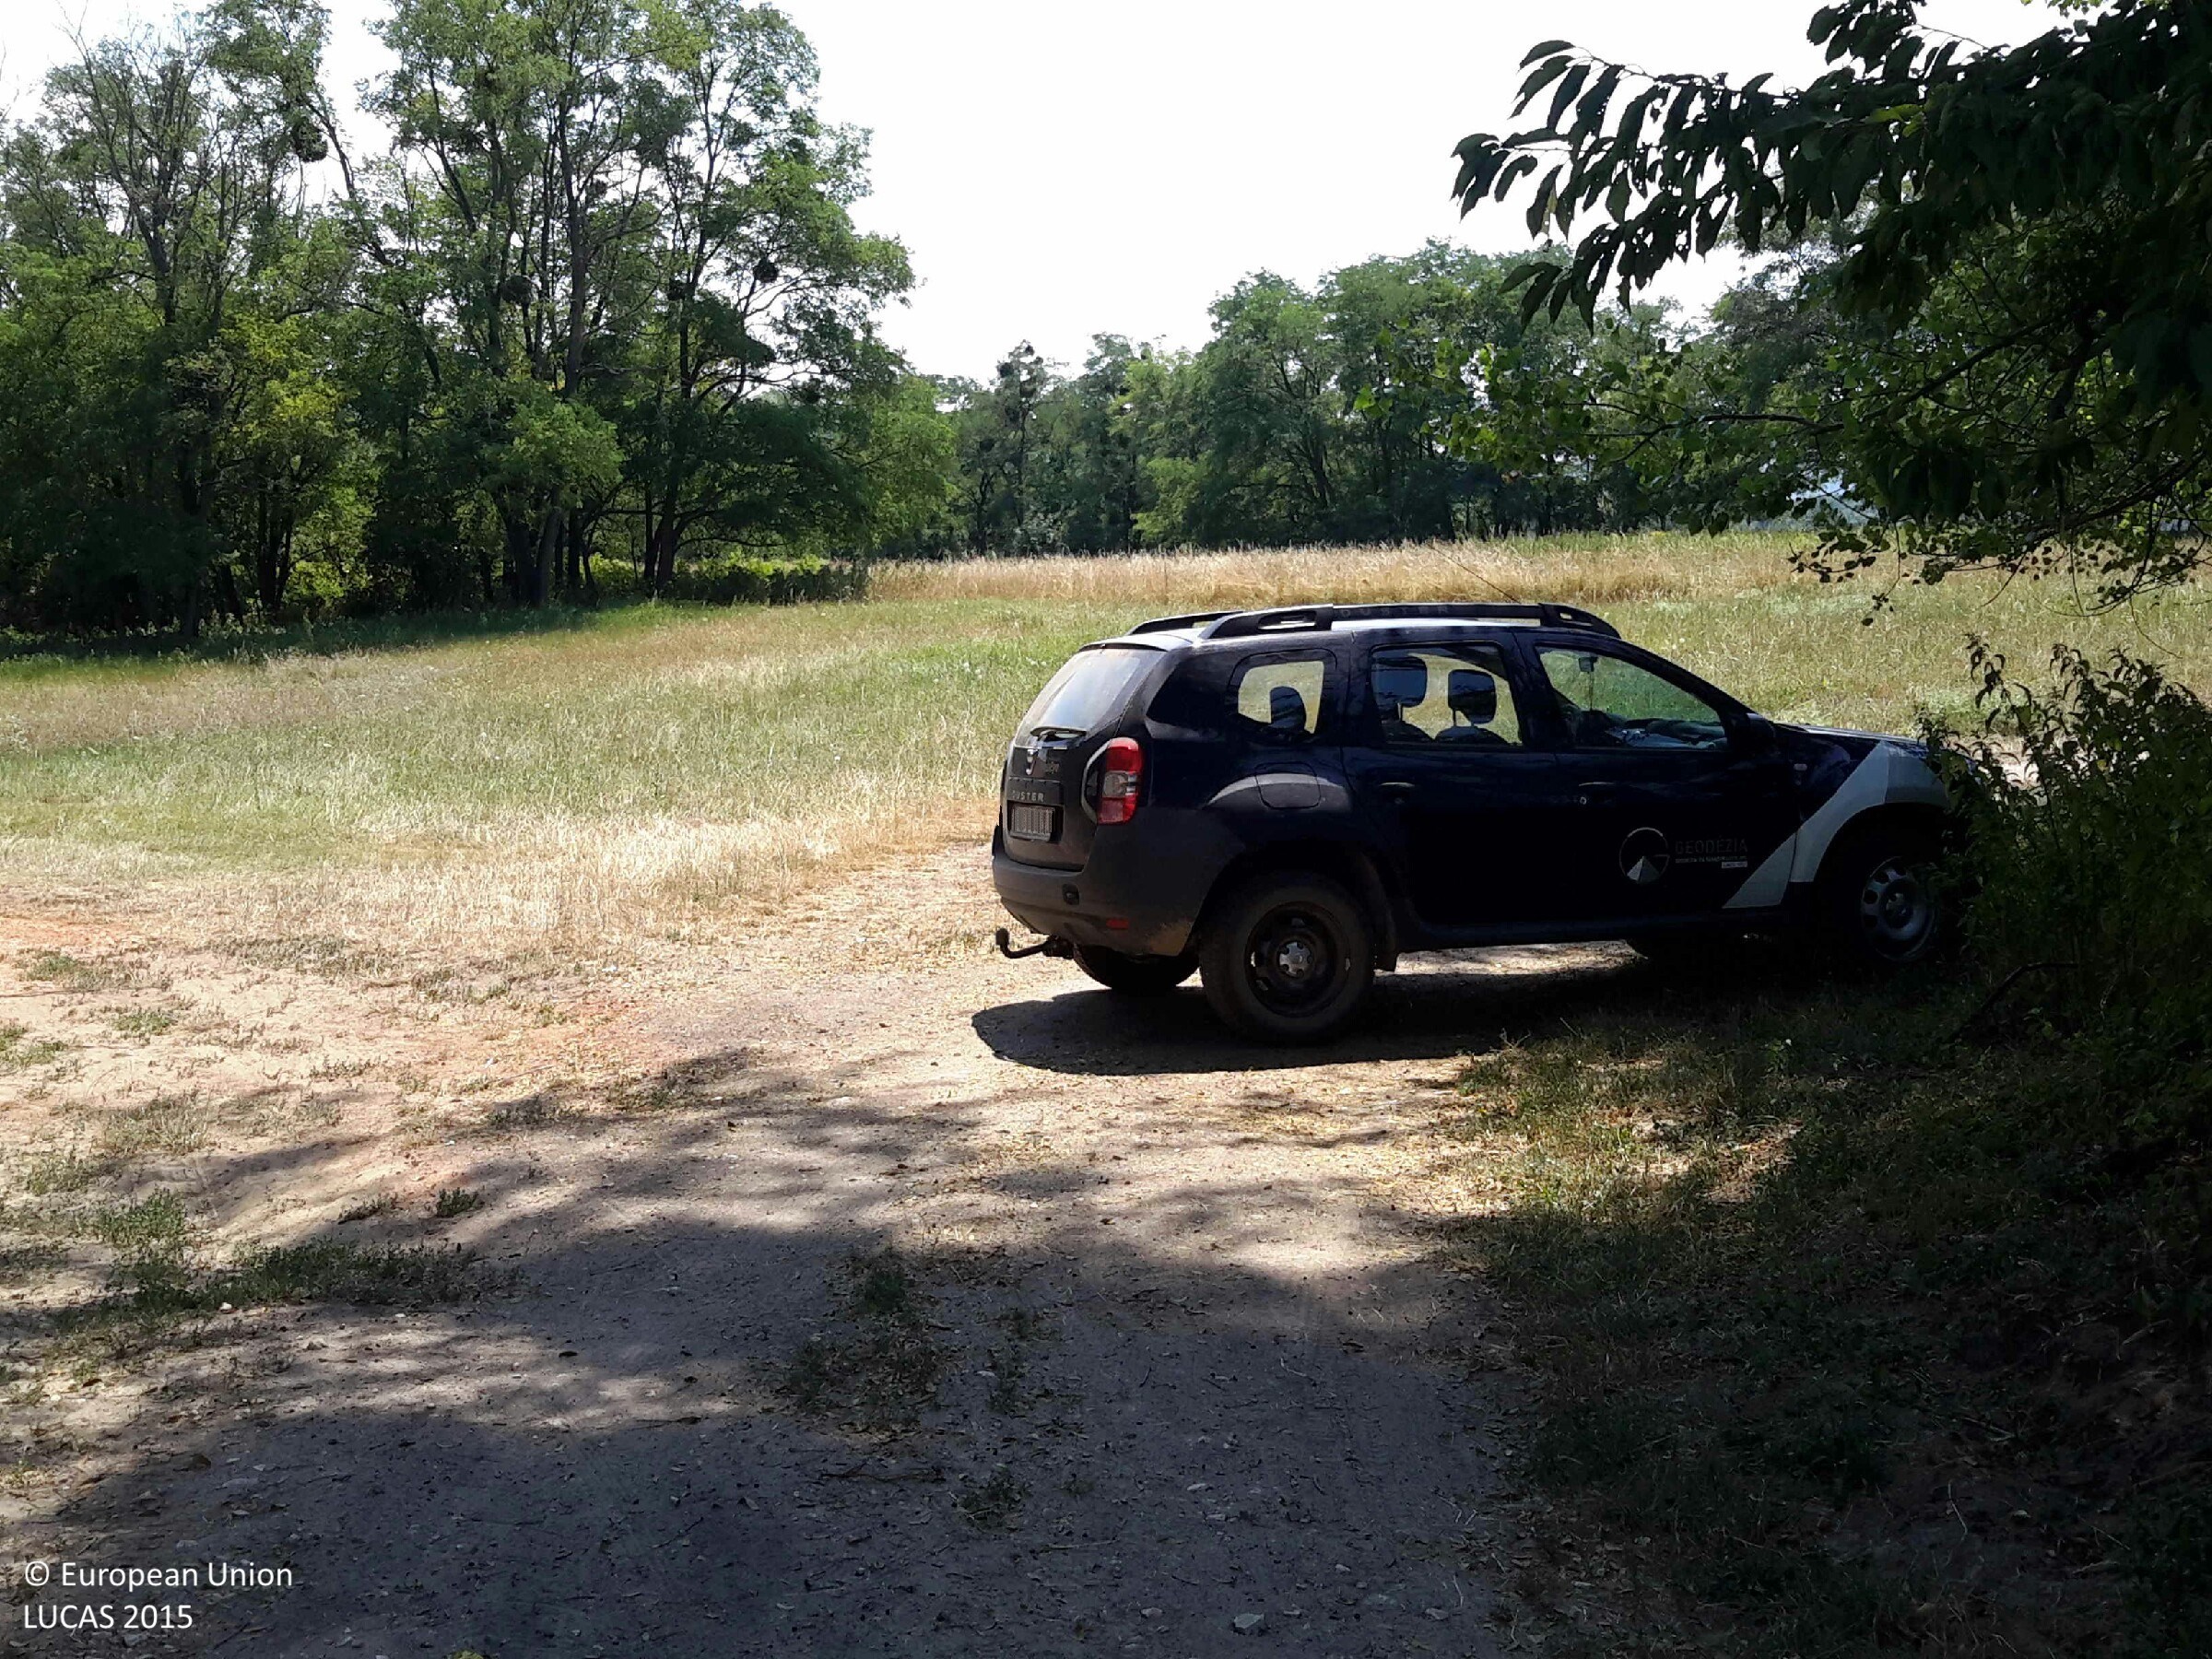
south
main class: Cropland
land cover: Permanent crops (only in case pi)
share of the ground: > 75 %
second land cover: Grassland without tree/shrub cover
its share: 50 - 75 %
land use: Agriculture (excluding fallow land and kitchen gardens)
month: July
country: HU
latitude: 47.4016
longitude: 17.8406
